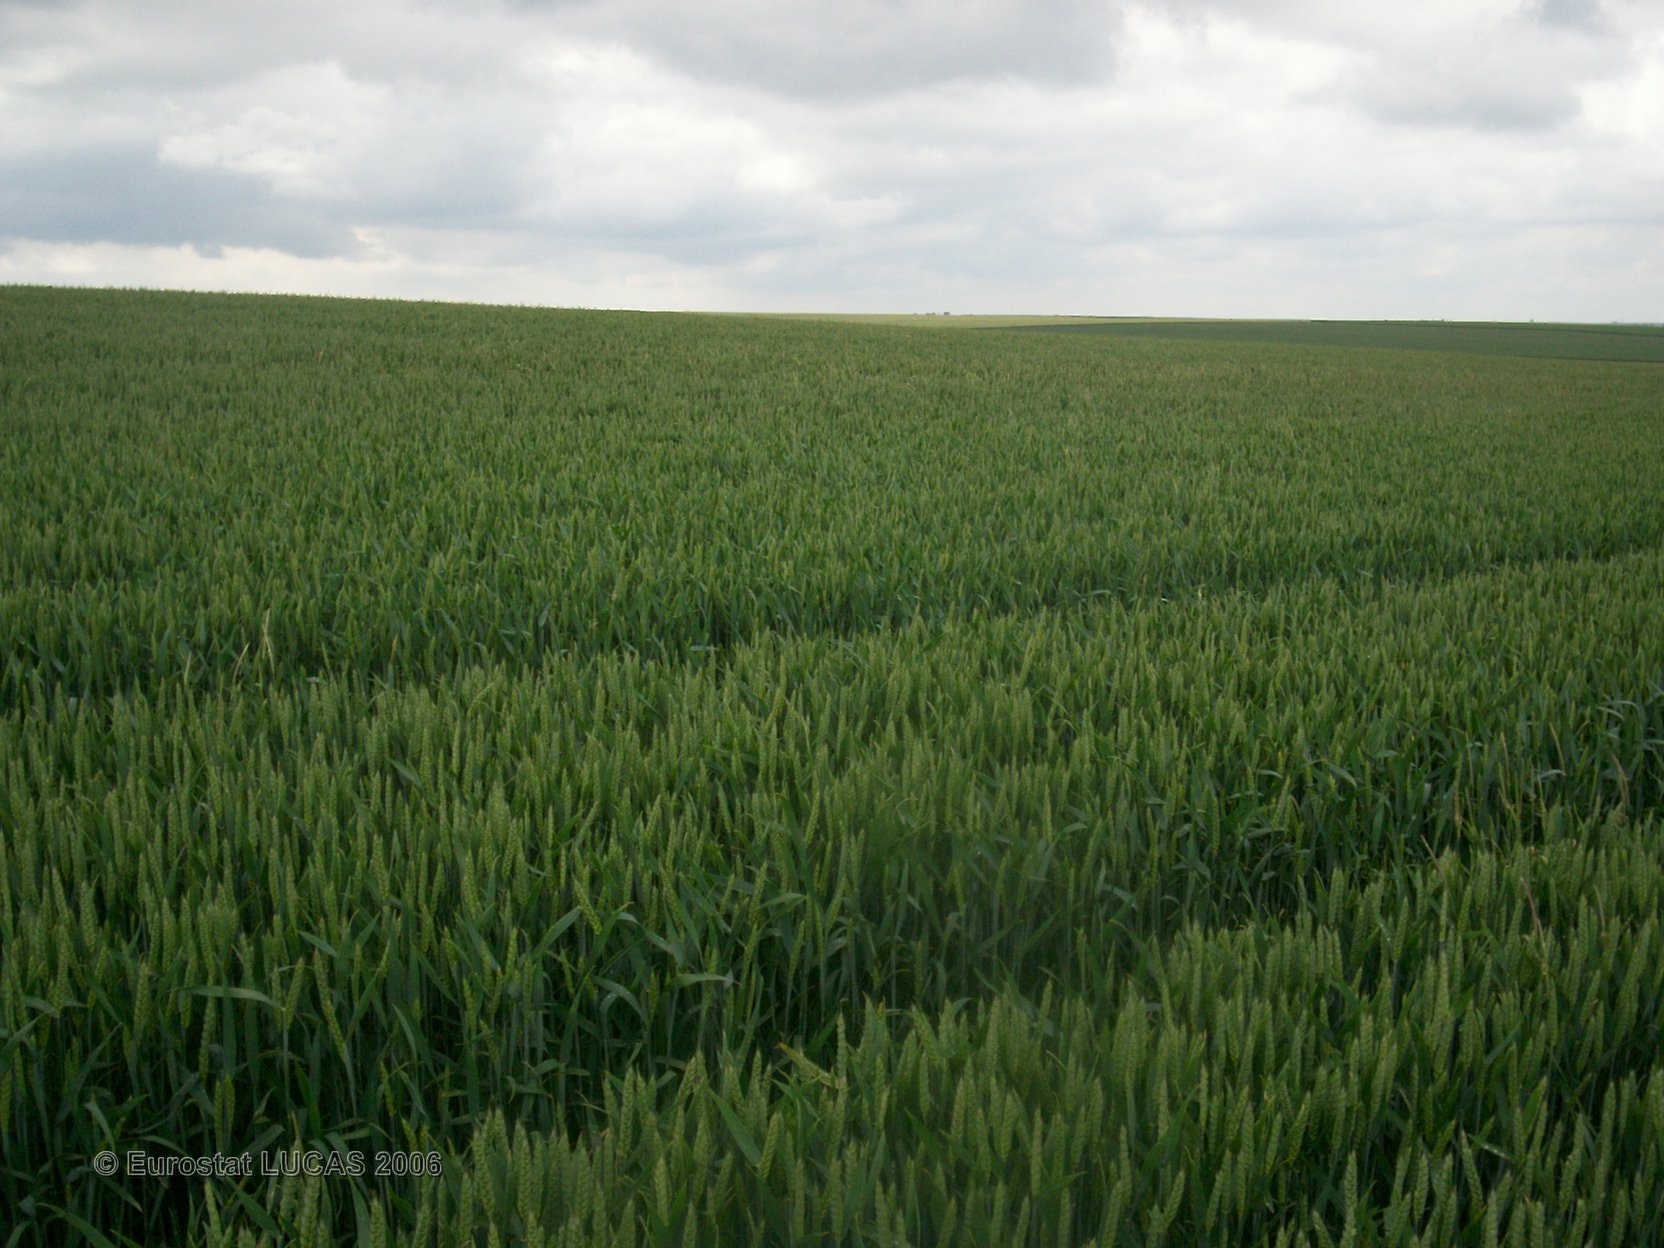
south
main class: Cropland
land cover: Common wheat
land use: Agriculture (excluding fallow land and kitchen gardens)
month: June
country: FR
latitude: 48.5889
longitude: 4.4520
